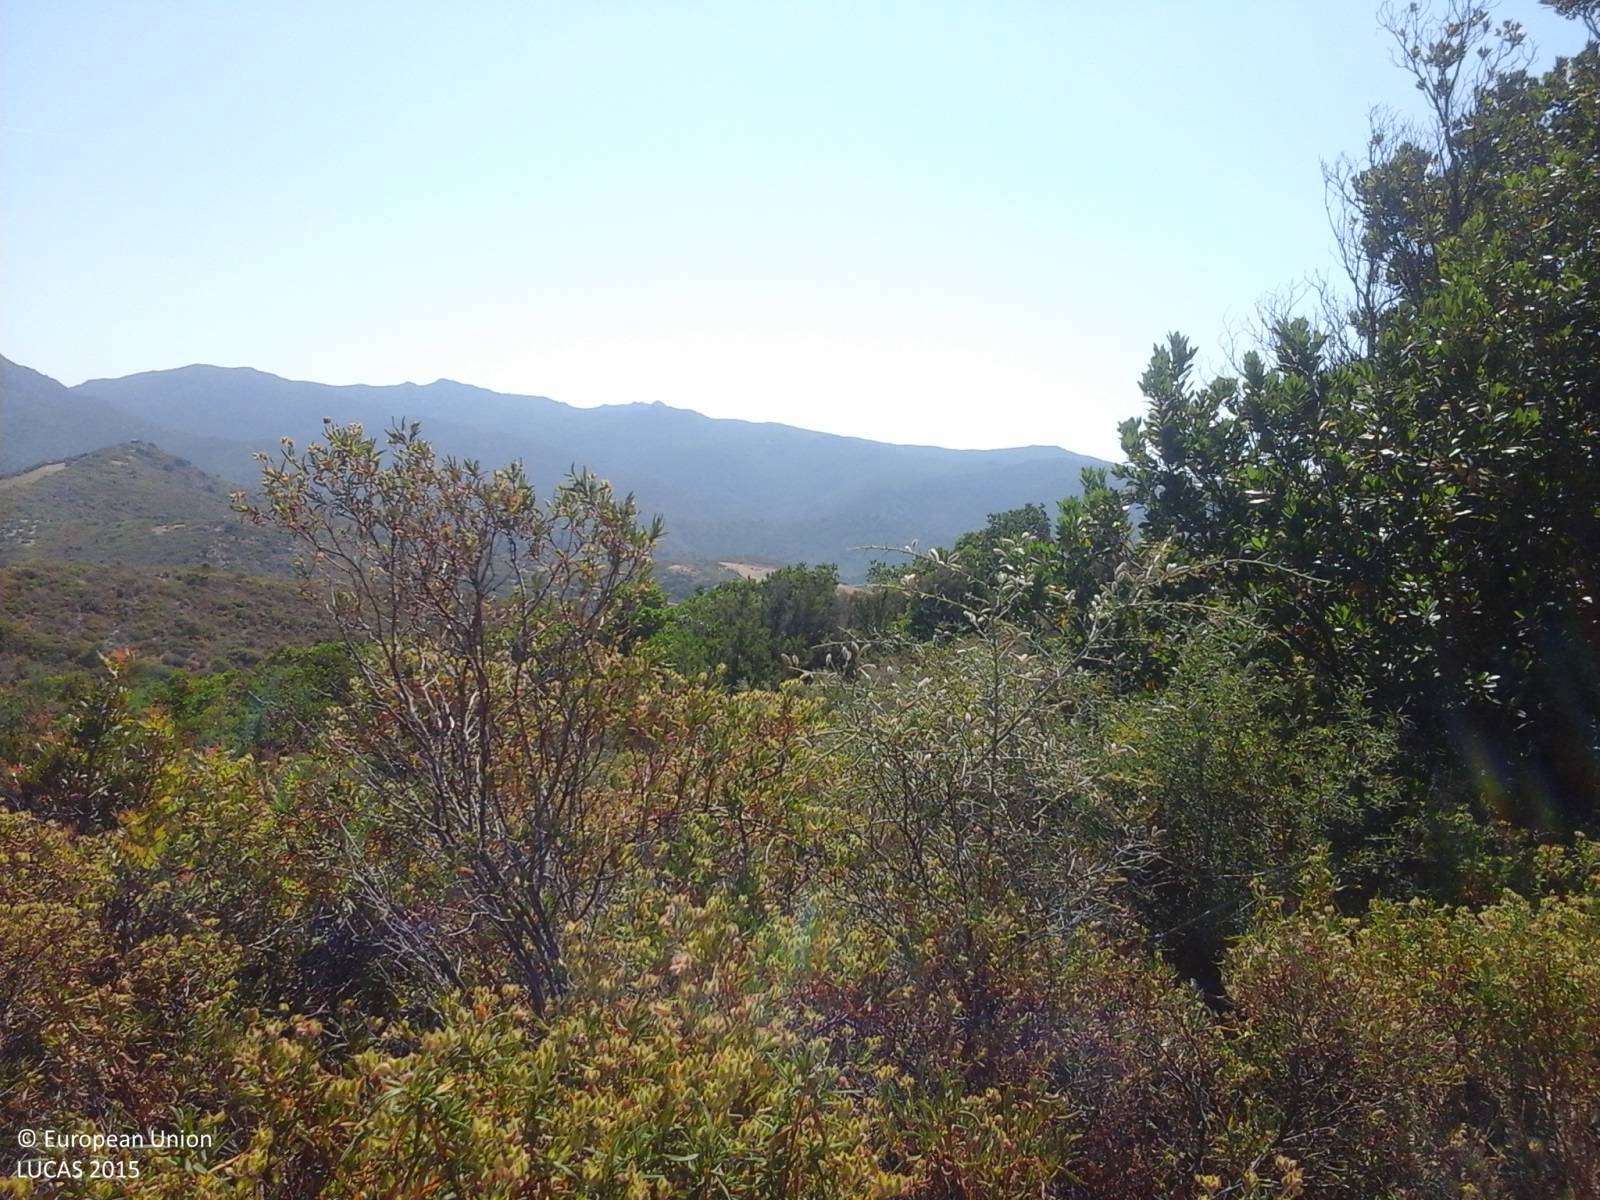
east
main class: Shrubland
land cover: Shrubland without tree cover
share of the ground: > 75 %
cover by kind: shrubs 90 %, herbaceous plants 10 %
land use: Semi-natural and natural areas not in use
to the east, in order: Shrubland without tree cover; Tracks; Shrubland without tree cover; Tracks; Shrubland without tree cover
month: June
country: IT
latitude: 38.9561
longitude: 8.8420
